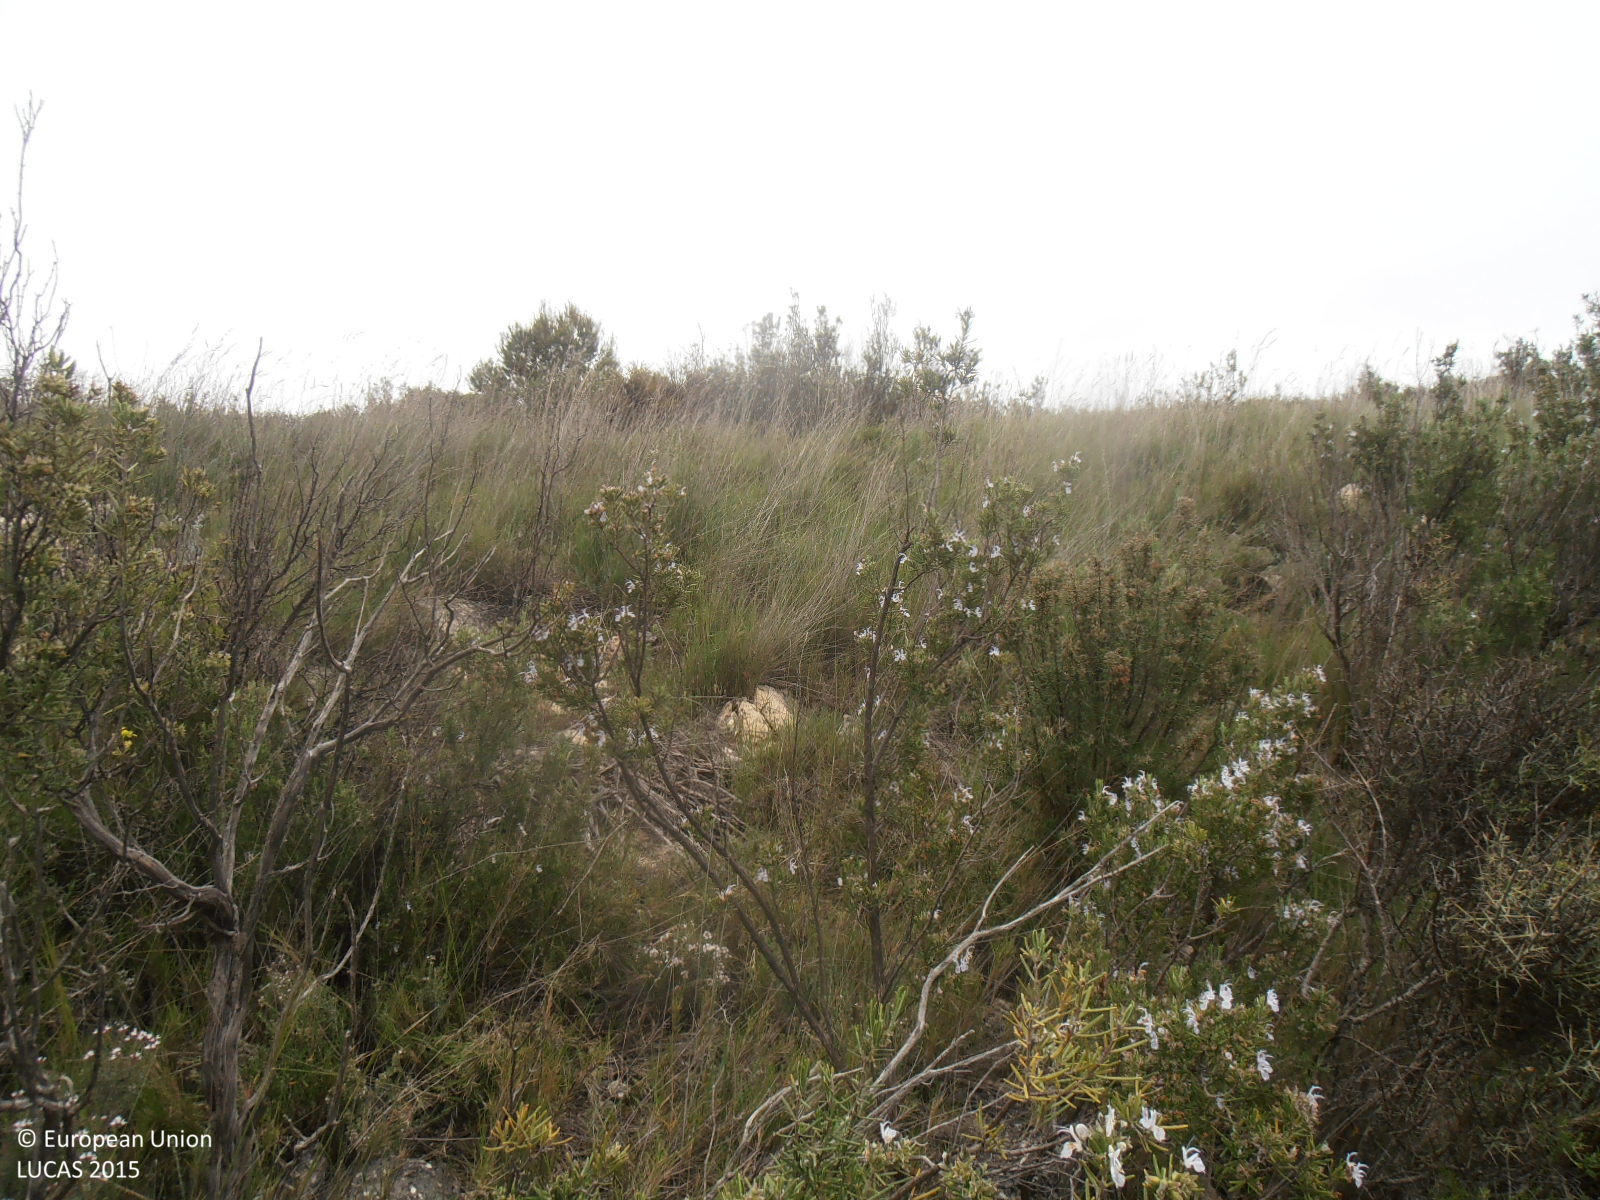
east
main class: Shrubland
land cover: Shrubland without tree cover
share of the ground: > 75 %
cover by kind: shrubs 65 %, consolidated bare surface 25 %, herbaceous plants 10 %
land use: Semi-natural and natural areas not in use
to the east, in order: Shrubland without tree cover; Barley; Shrubland without tree cover; Spontaneously vegetated surfaces; Shrubland without tree cover; Spontaneously vegetated surfaces; Shruby margins; Spontaneously vegetated surfaces; Dry stone walls; Shrubland without tree cover; Spontaneously vegetated surfaces; Shrubland without tree cover; Dry stone walls; Spontaneously vegetated surfaces; Shrubland without tree cover
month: May
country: ES
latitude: 41.4164
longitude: -0.9915
